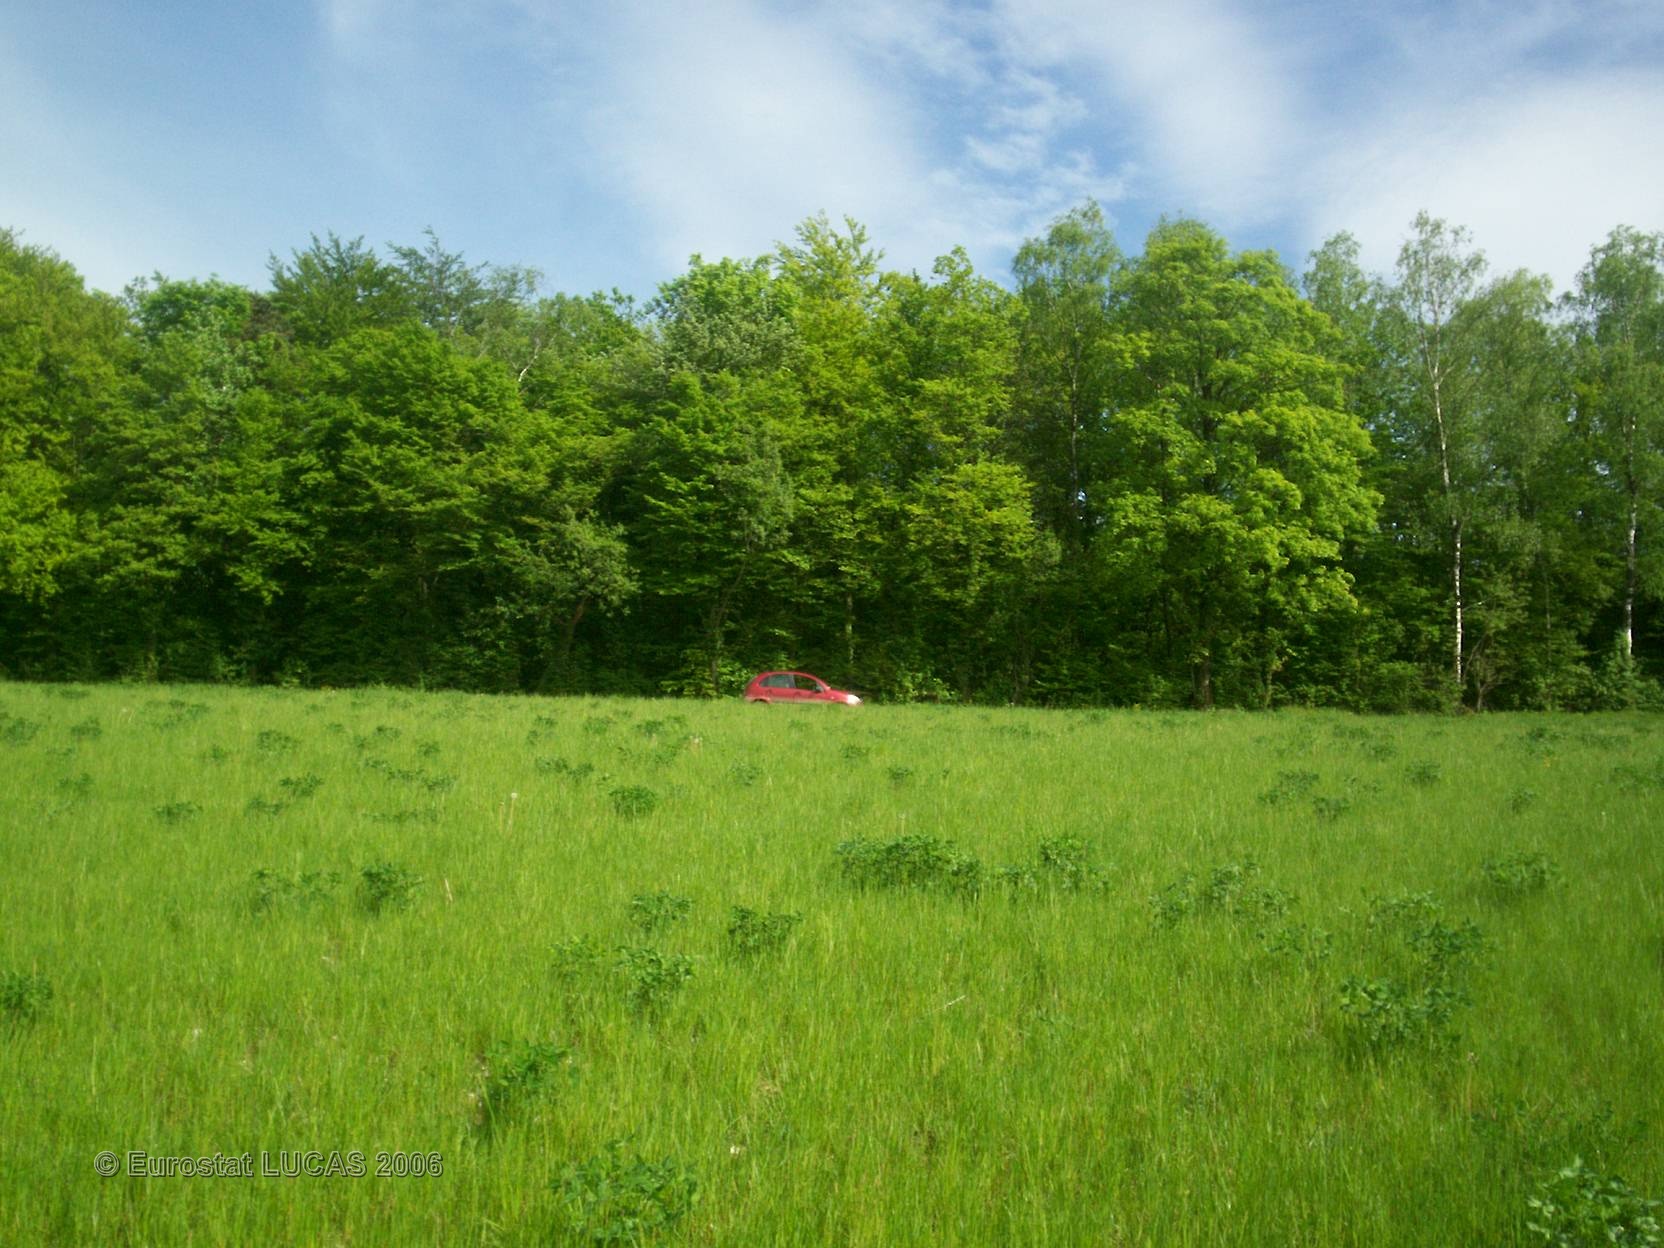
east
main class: Grassland
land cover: Grassland without tree/shrub cover
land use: Agriculture (excluding fallow land and kitchen gardens)
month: May
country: FR
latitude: 48.7486
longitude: 5.1703
